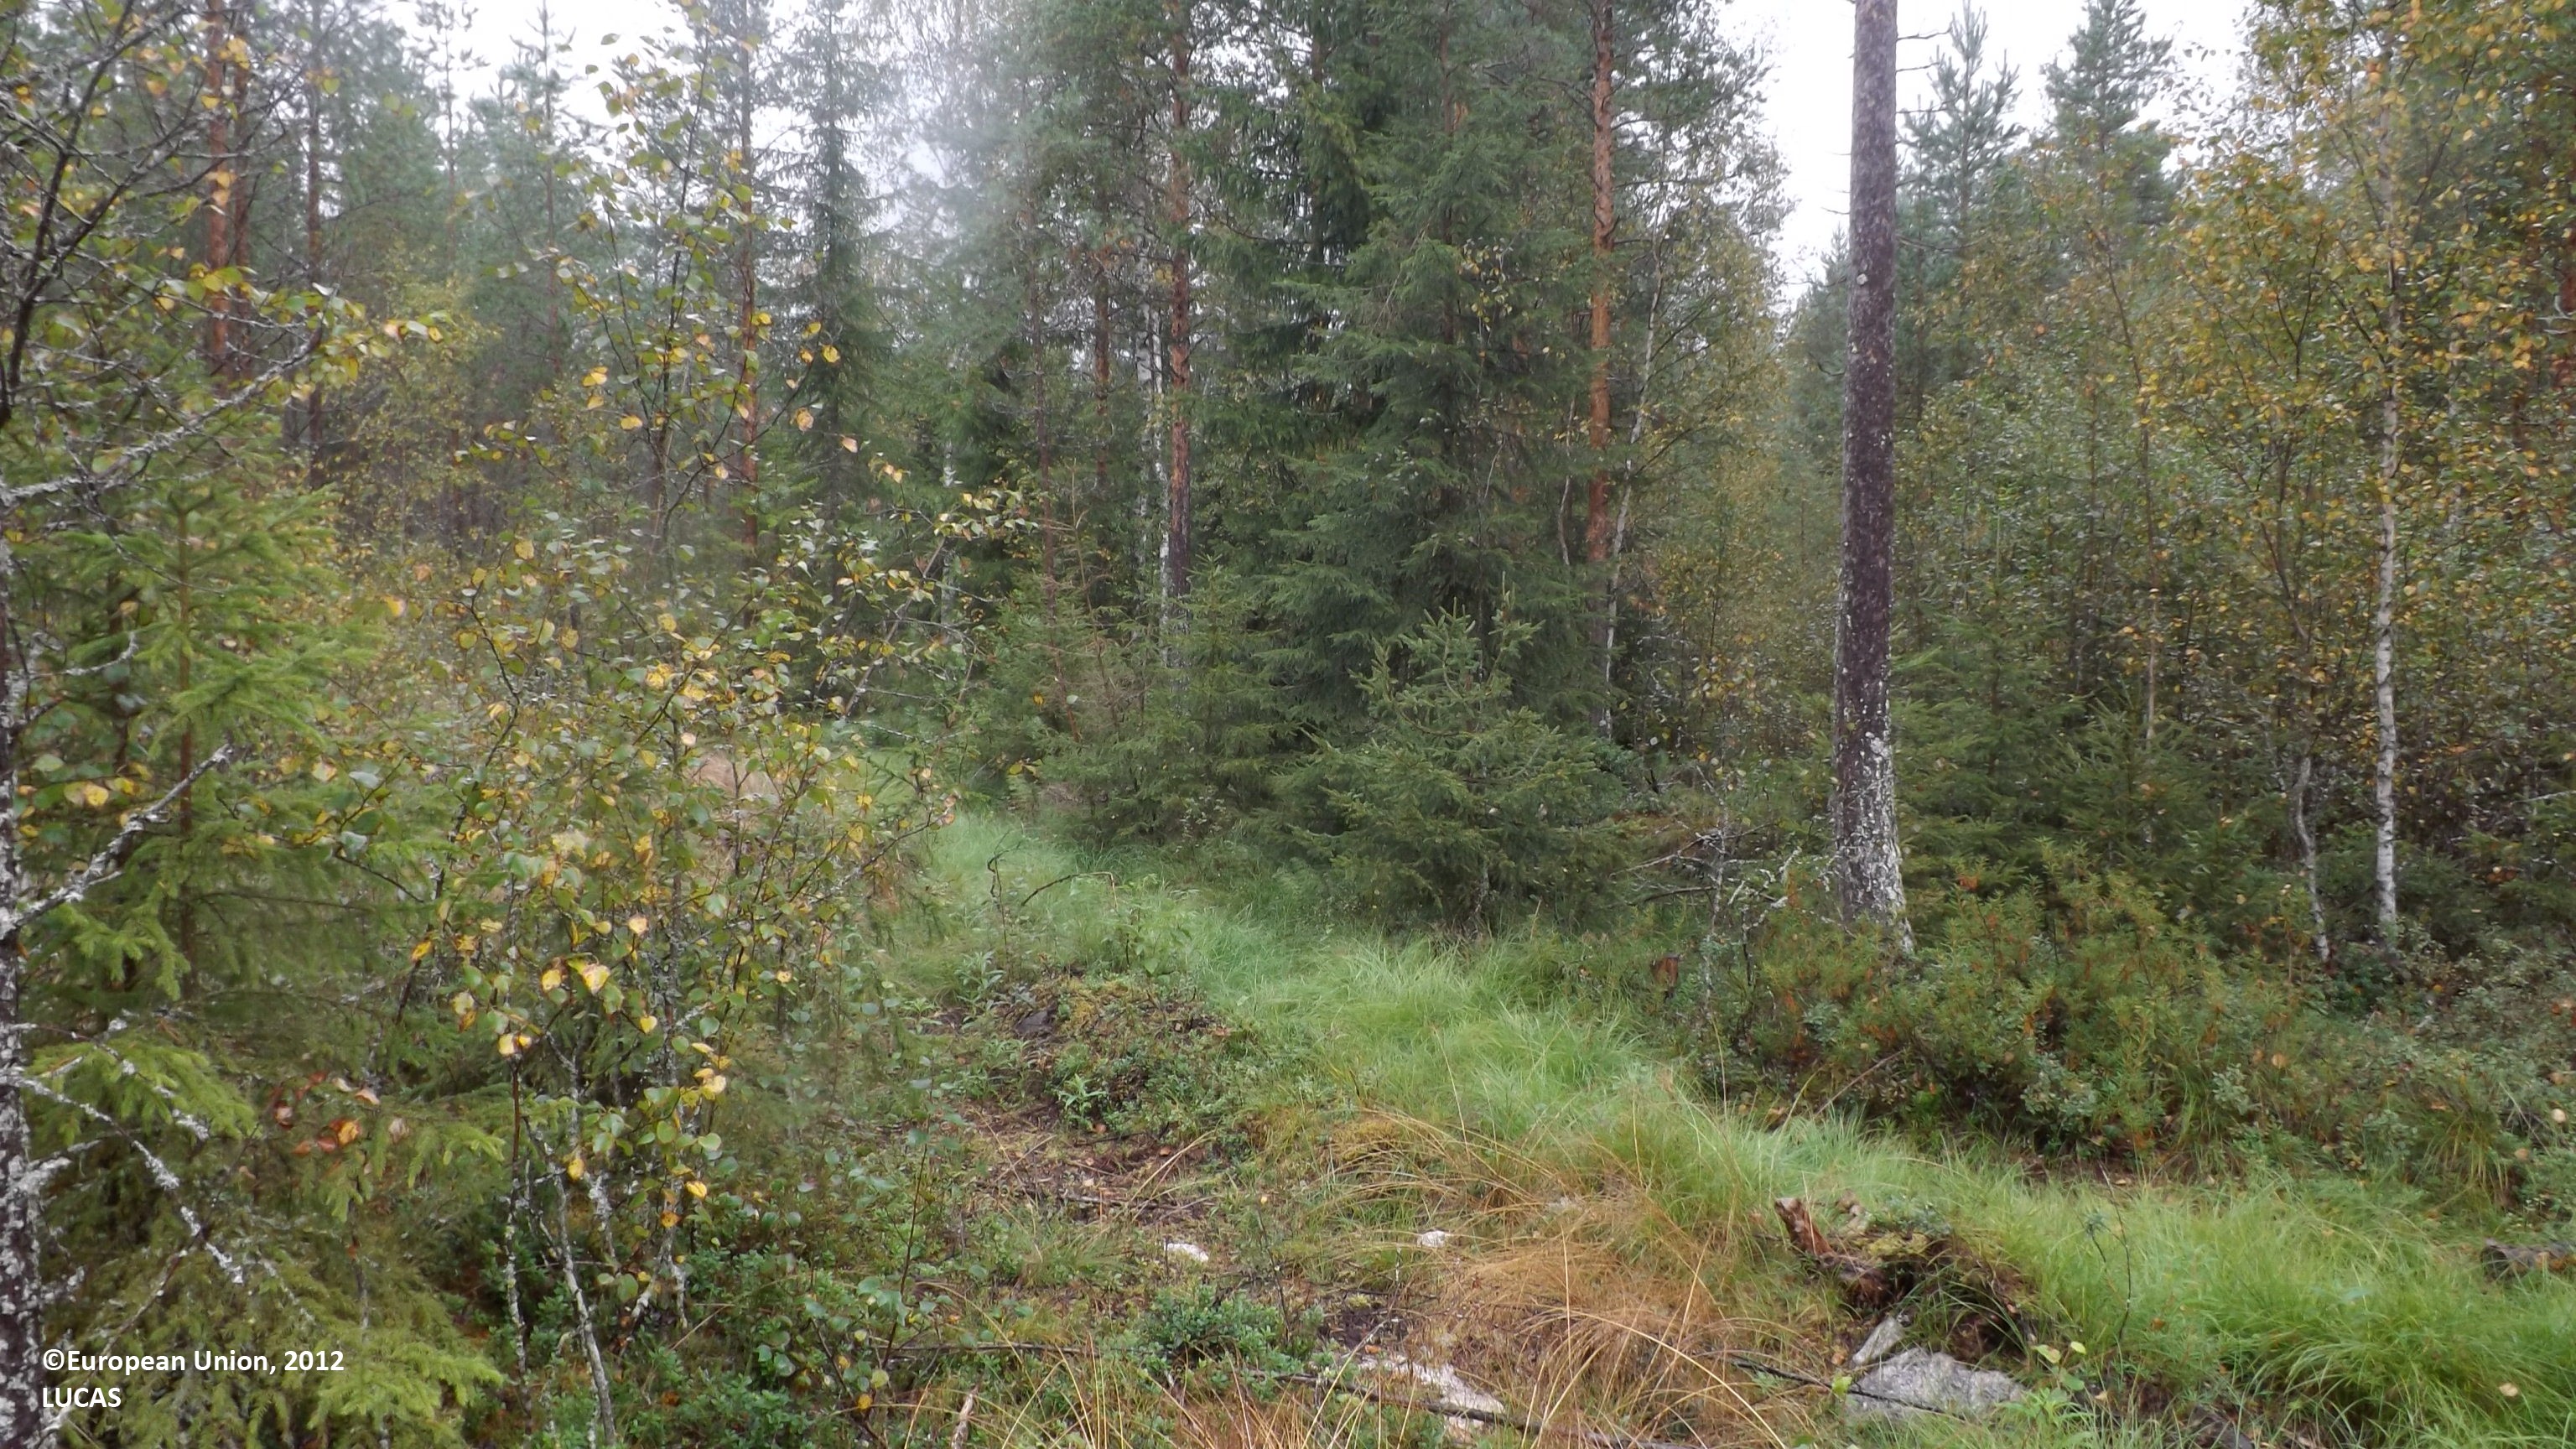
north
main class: Woodland
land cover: Pine dominated mixed woodland
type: boreal forest
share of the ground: 25 - 50 %
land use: Forestry
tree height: > 5 m
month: August
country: FI
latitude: 63.7912
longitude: 23.5971
